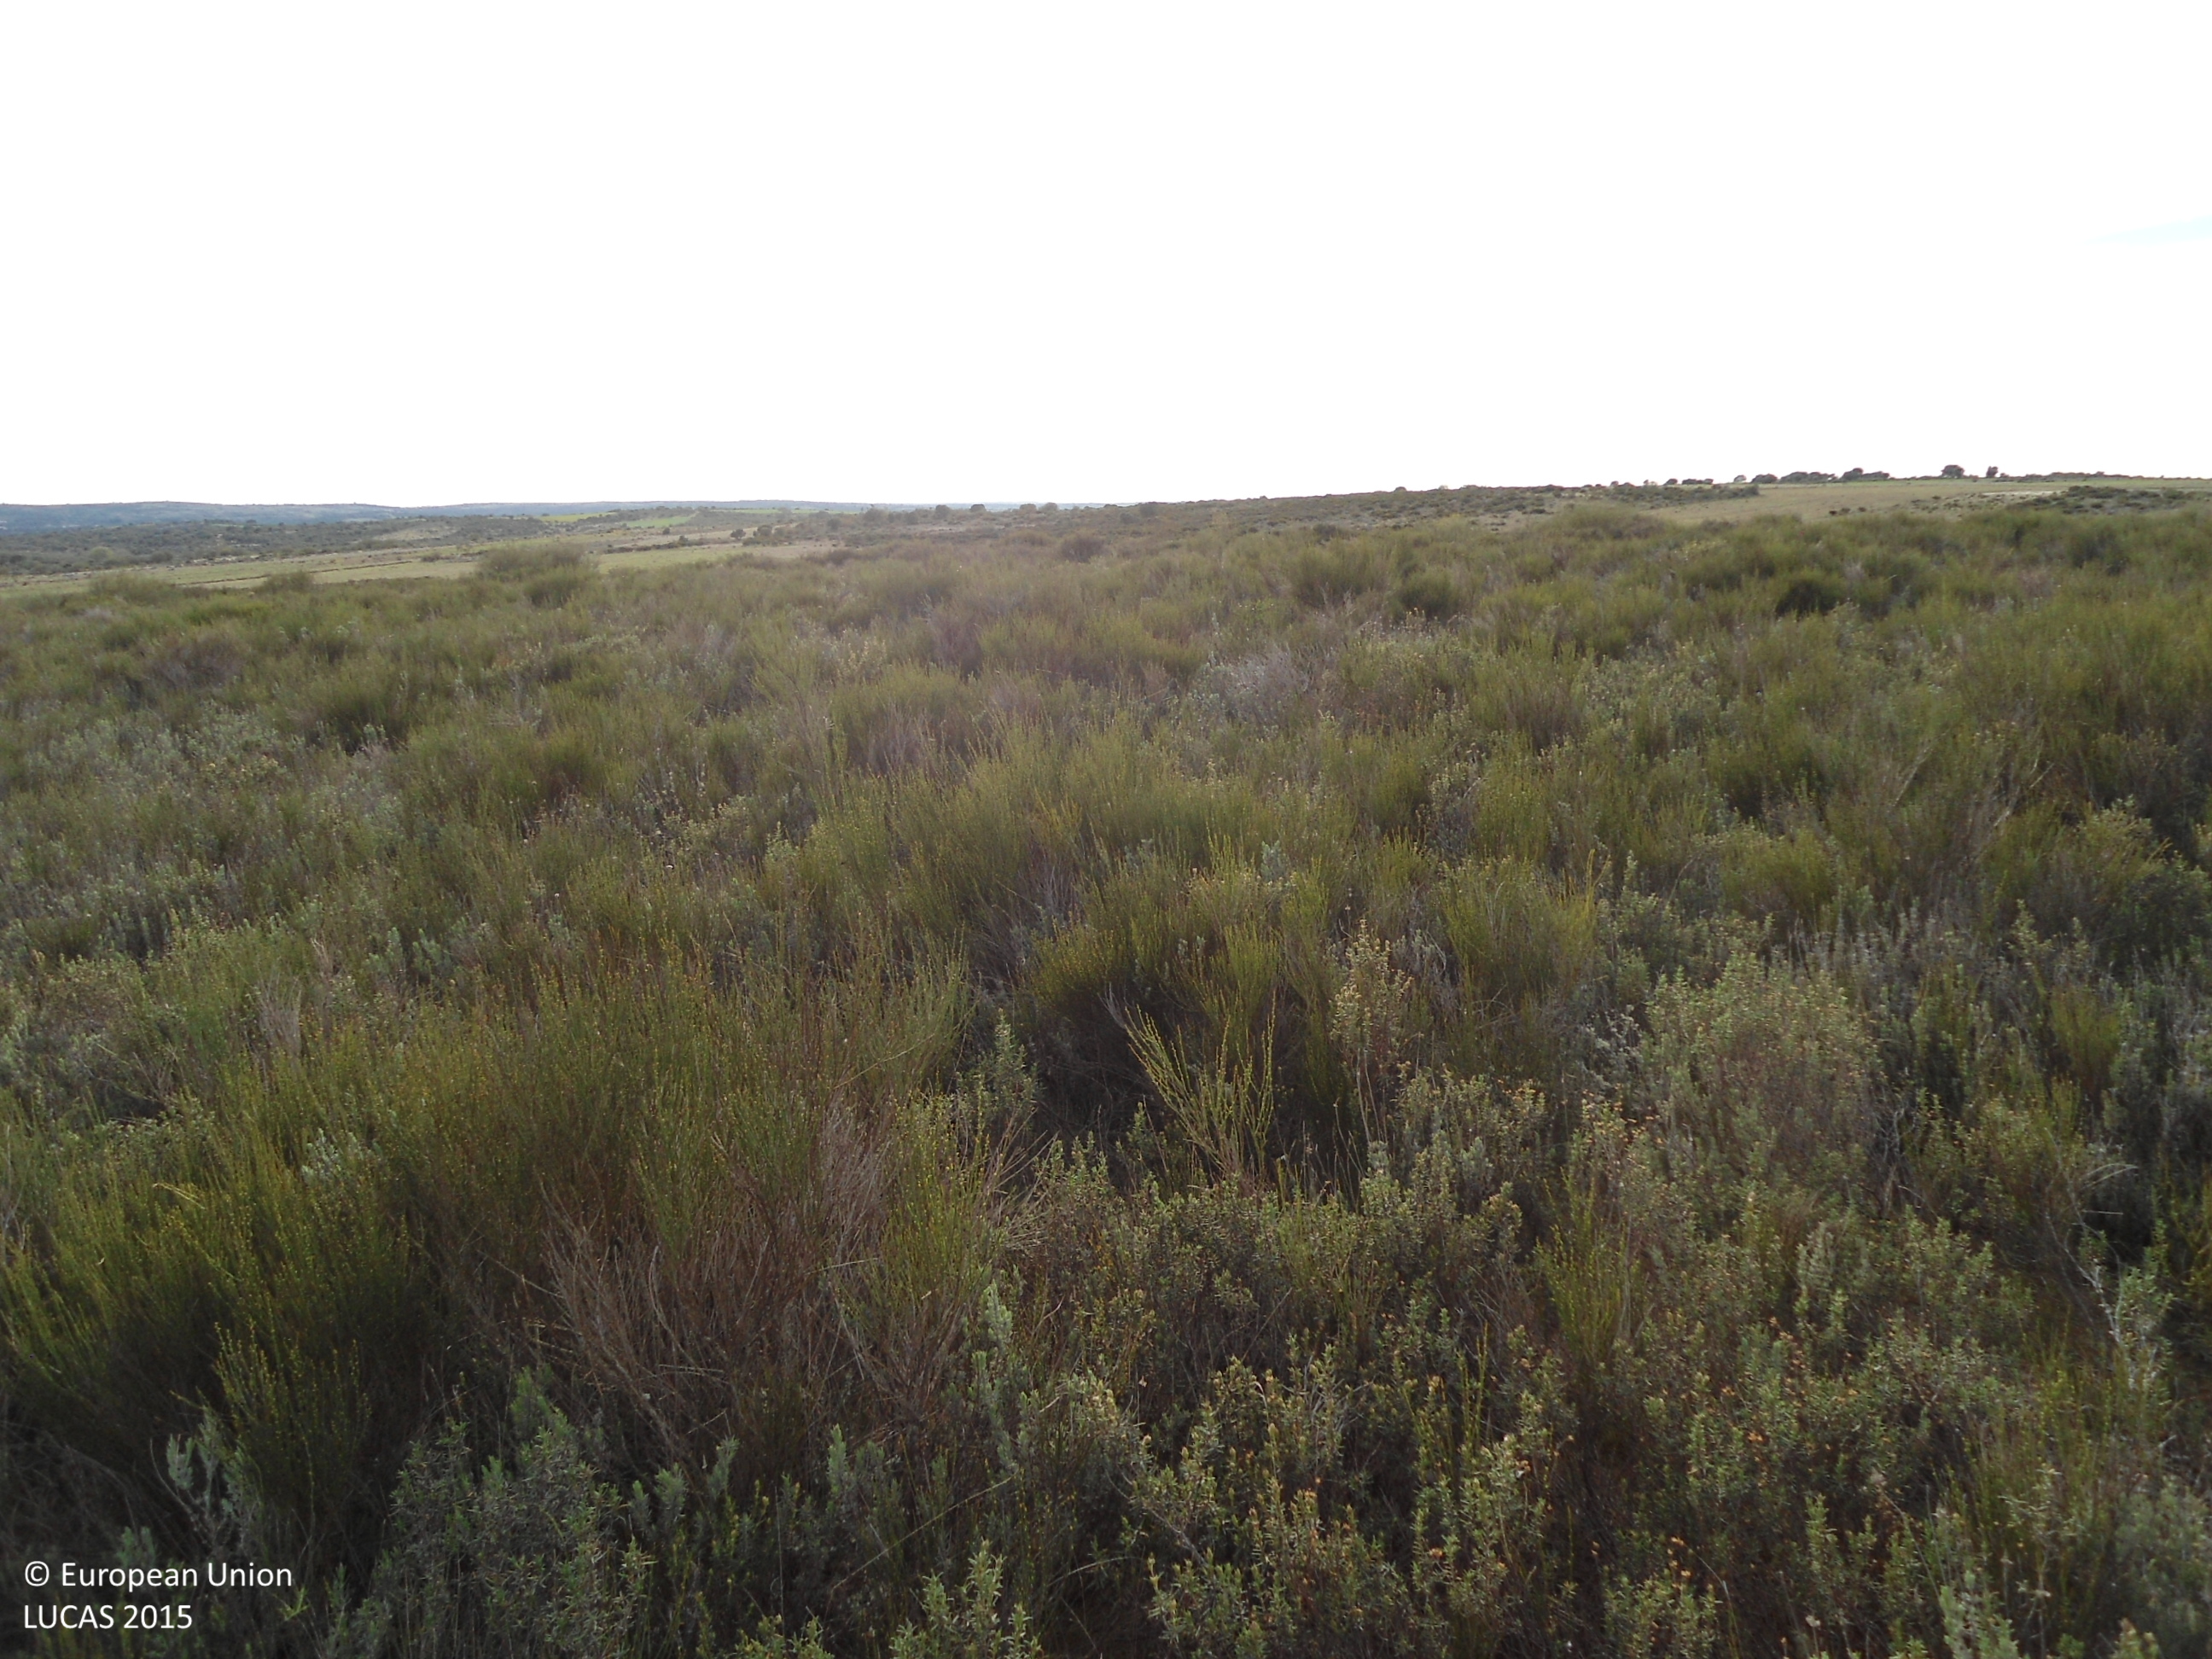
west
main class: Shrubland
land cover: Shrubland without tree cover
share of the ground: > 75 %
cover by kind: shrubs 90 %, herbaceous plants 10 %
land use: Fallow land
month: April
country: ES
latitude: 41.5795
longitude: -6.0828
